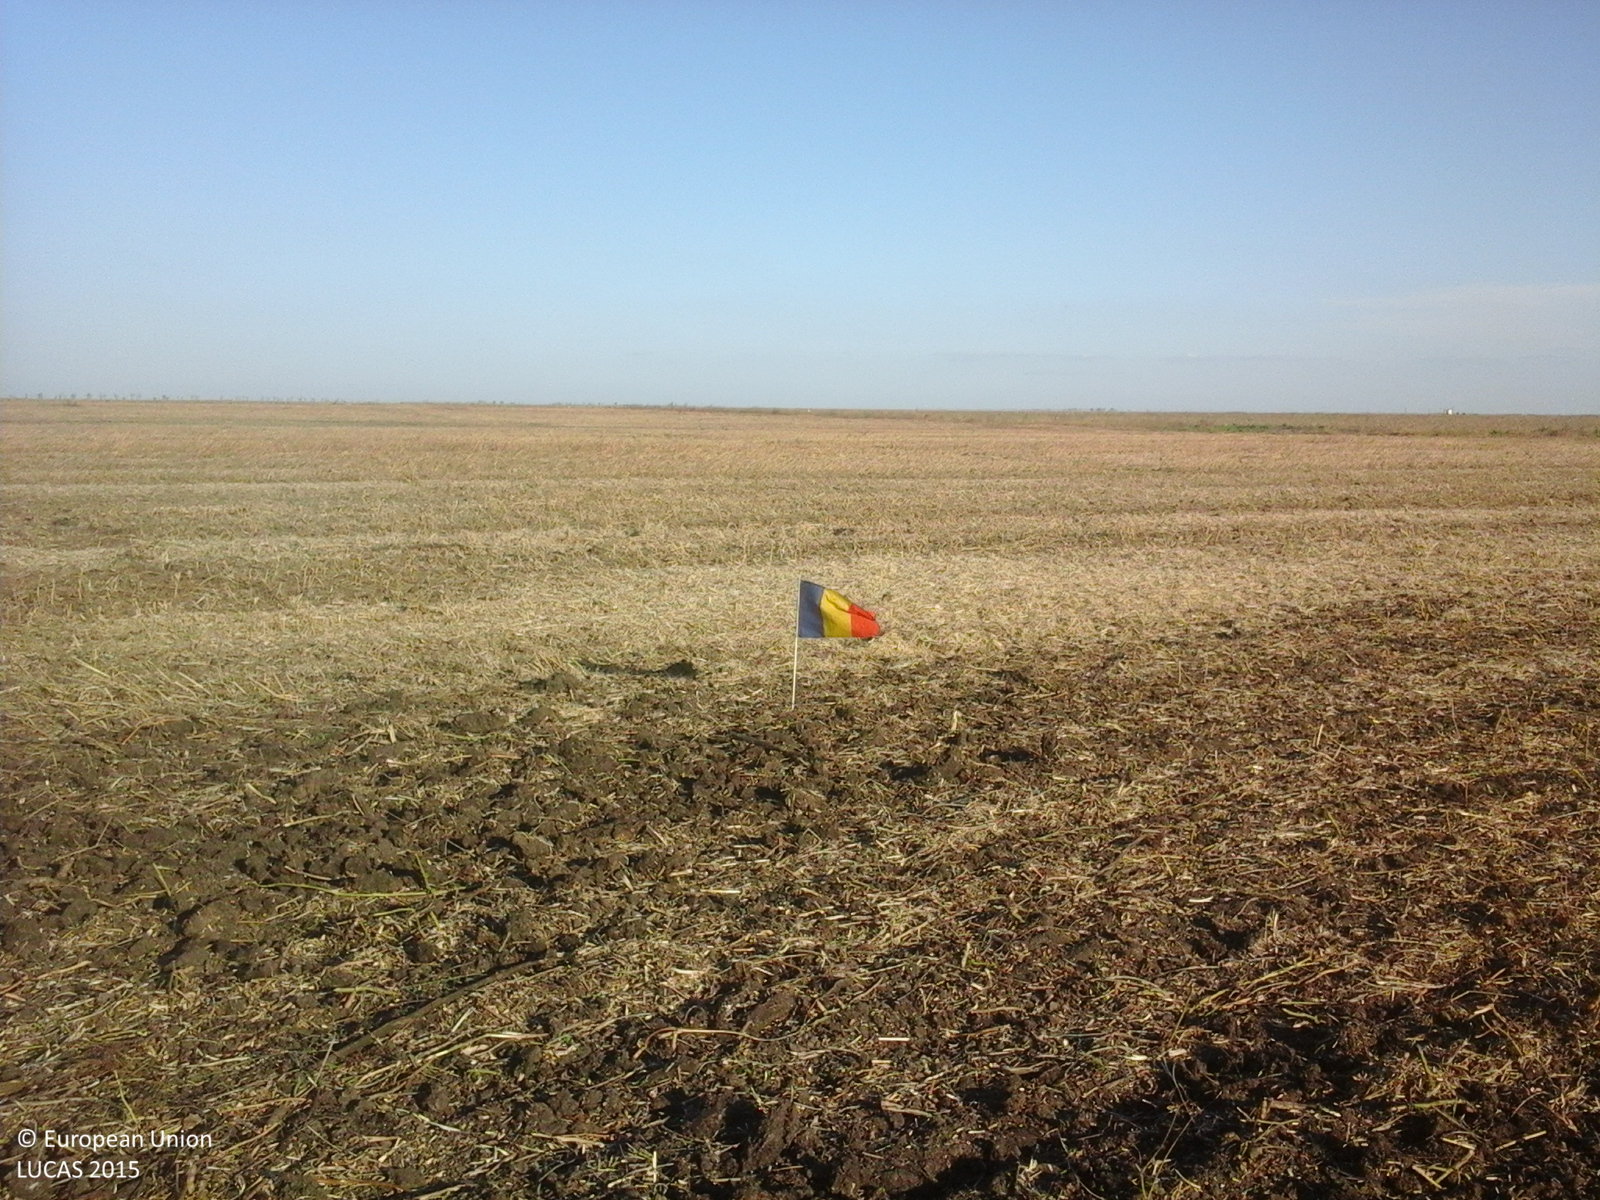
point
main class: Cropland
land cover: Soya
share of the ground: 25 - 50 %
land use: Agriculture (excluding fallow land and kitchen gardens)
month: October
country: RO
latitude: 45.3670
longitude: 27.4246
